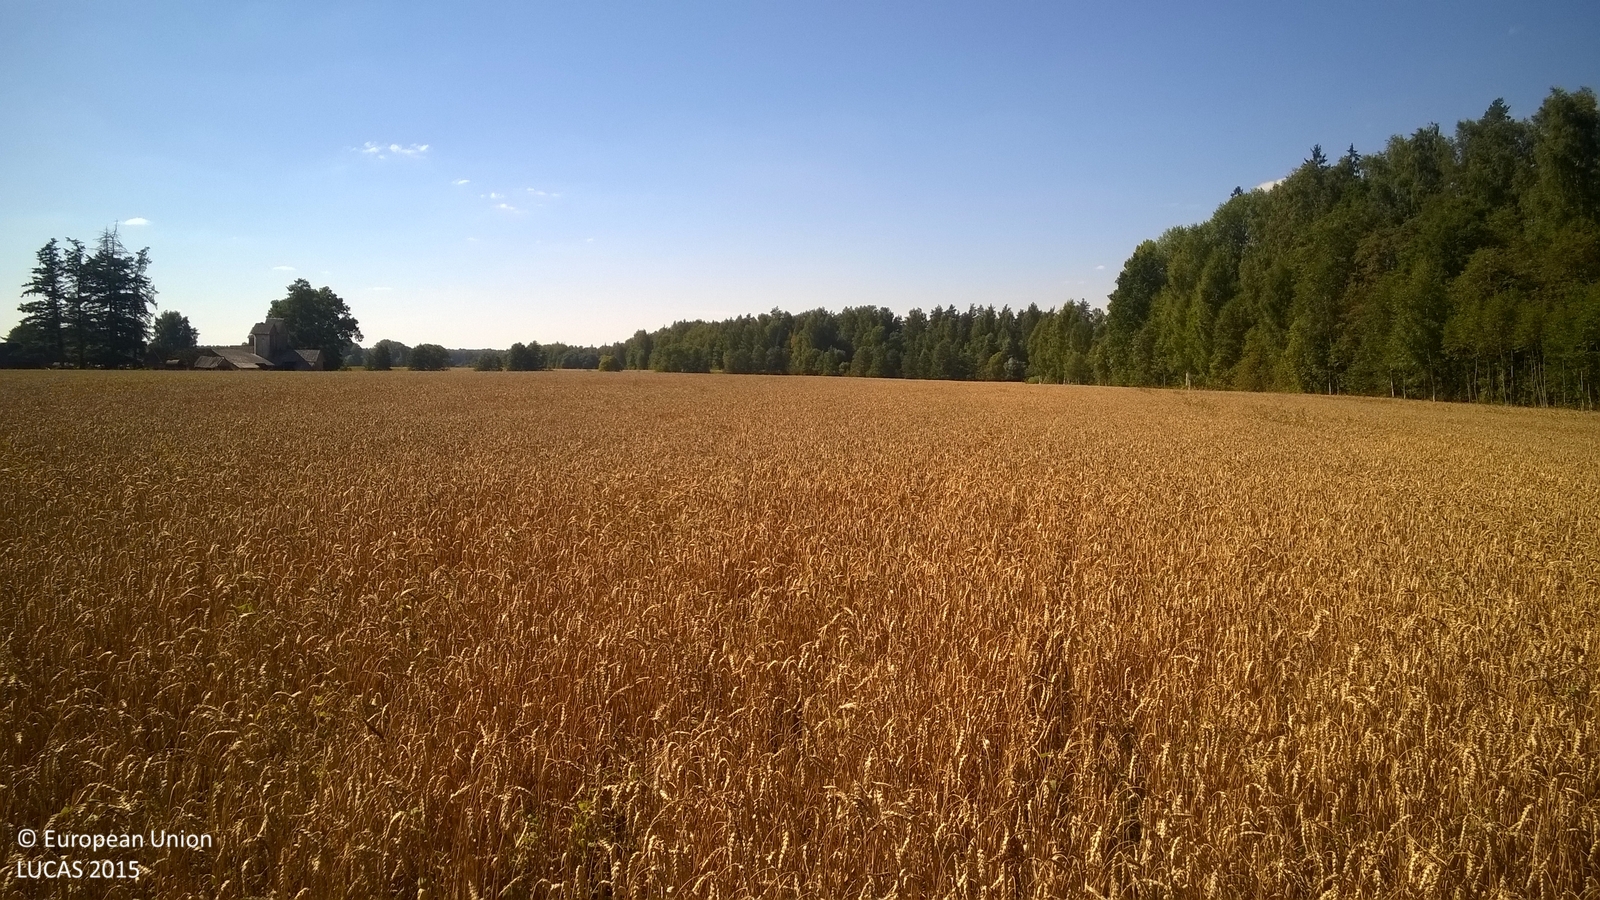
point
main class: Cropland
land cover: Common wheat
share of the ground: > 75 %
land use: Agriculture (excluding fallow land and kitchen gardens)
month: August
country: LV
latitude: 57.5476
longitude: 25.9844
